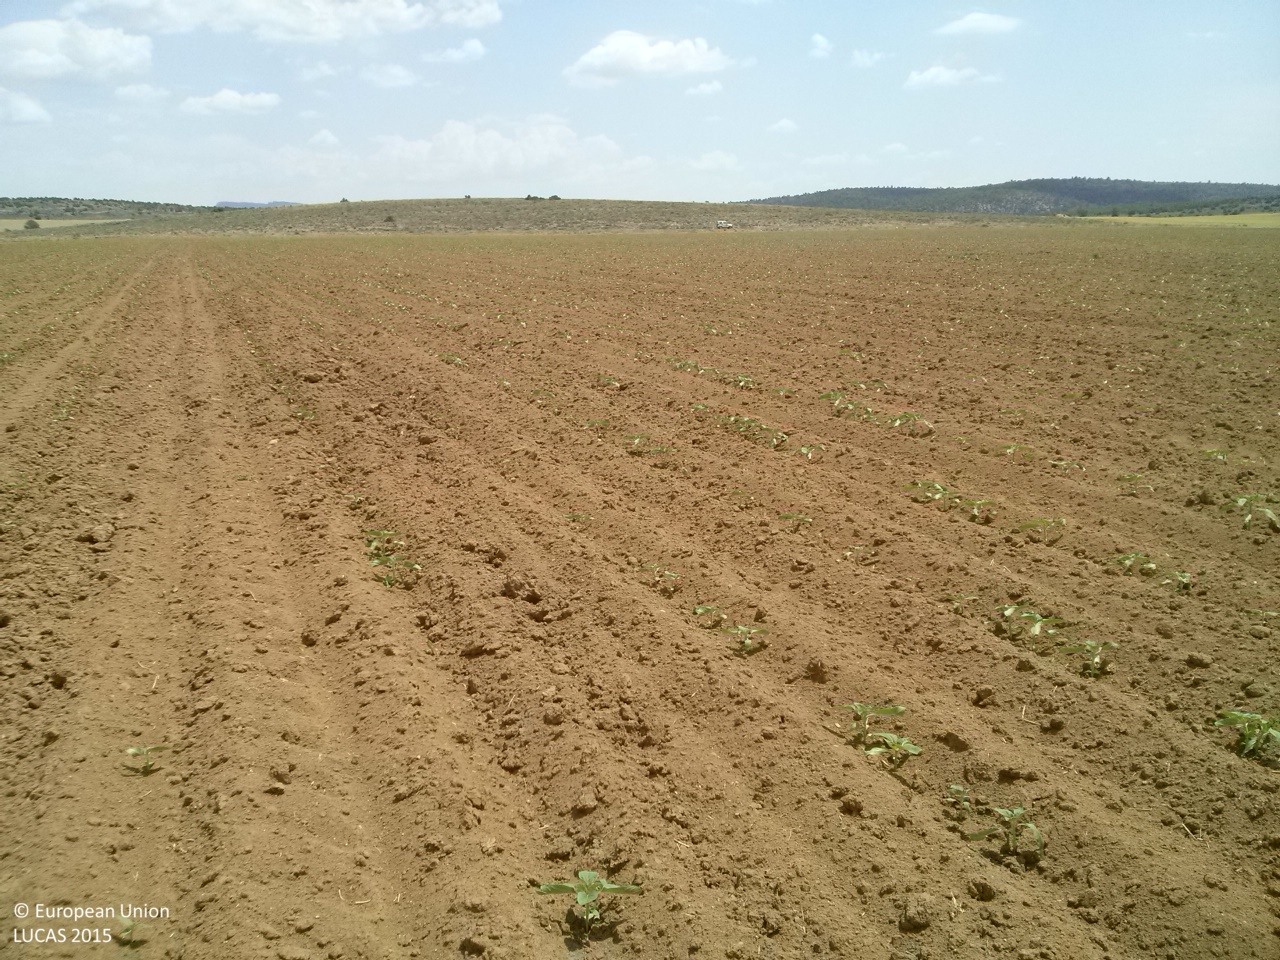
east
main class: Cropland
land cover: Sunflower
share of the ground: < 10 %
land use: Agriculture (excluding fallow land and kitchen gardens)
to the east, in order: Sunflower; Grass margins; Tracks; Grass margins; Shrubland without tree cover
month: June
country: ES
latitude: 39.9188
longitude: -1.7924
